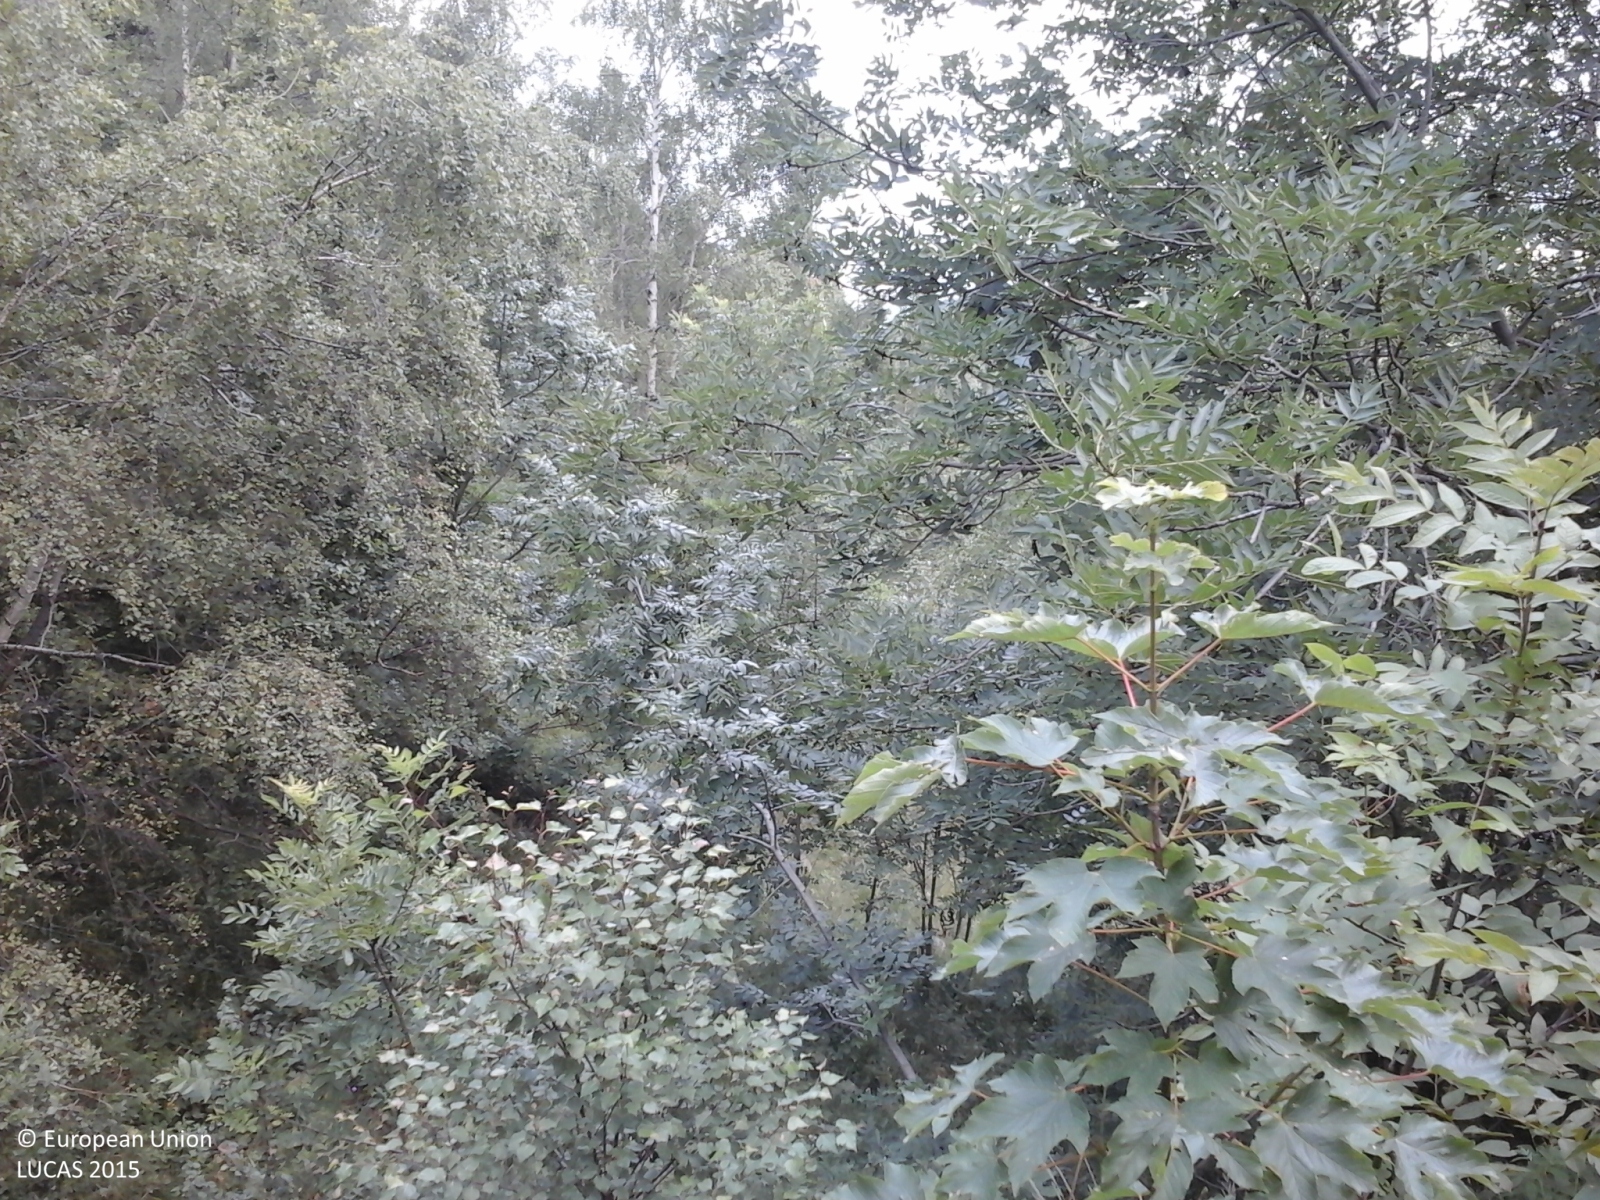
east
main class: Woodland
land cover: Other mixed woodland
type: mesophytic deciduous forest
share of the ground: > 75 %
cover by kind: broadleaved forest trees 65 %, coniferous forest trees 25 %, shrubs 10 %
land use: Semi-natural and natural areas not in use
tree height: > 5 m
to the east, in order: Other mixed woodland; Rivers and streams; Other mixed woodland; Tracks; Other mixed woodland; Paved roads, cycling and walking lanes; Broadleaved woodland; Grassland with sparse tree/shrub cover; Abandoned hedges; Dry stone walls; Grassland without tree/shrub cover; Abandoned hedges; Dry stone walls; Grassland without tree/shrub cover; Abandoned hedges; Dry stone walls; Grassland without tree/shrub cover
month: July
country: IT
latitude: 45.5528
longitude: 7.7617
